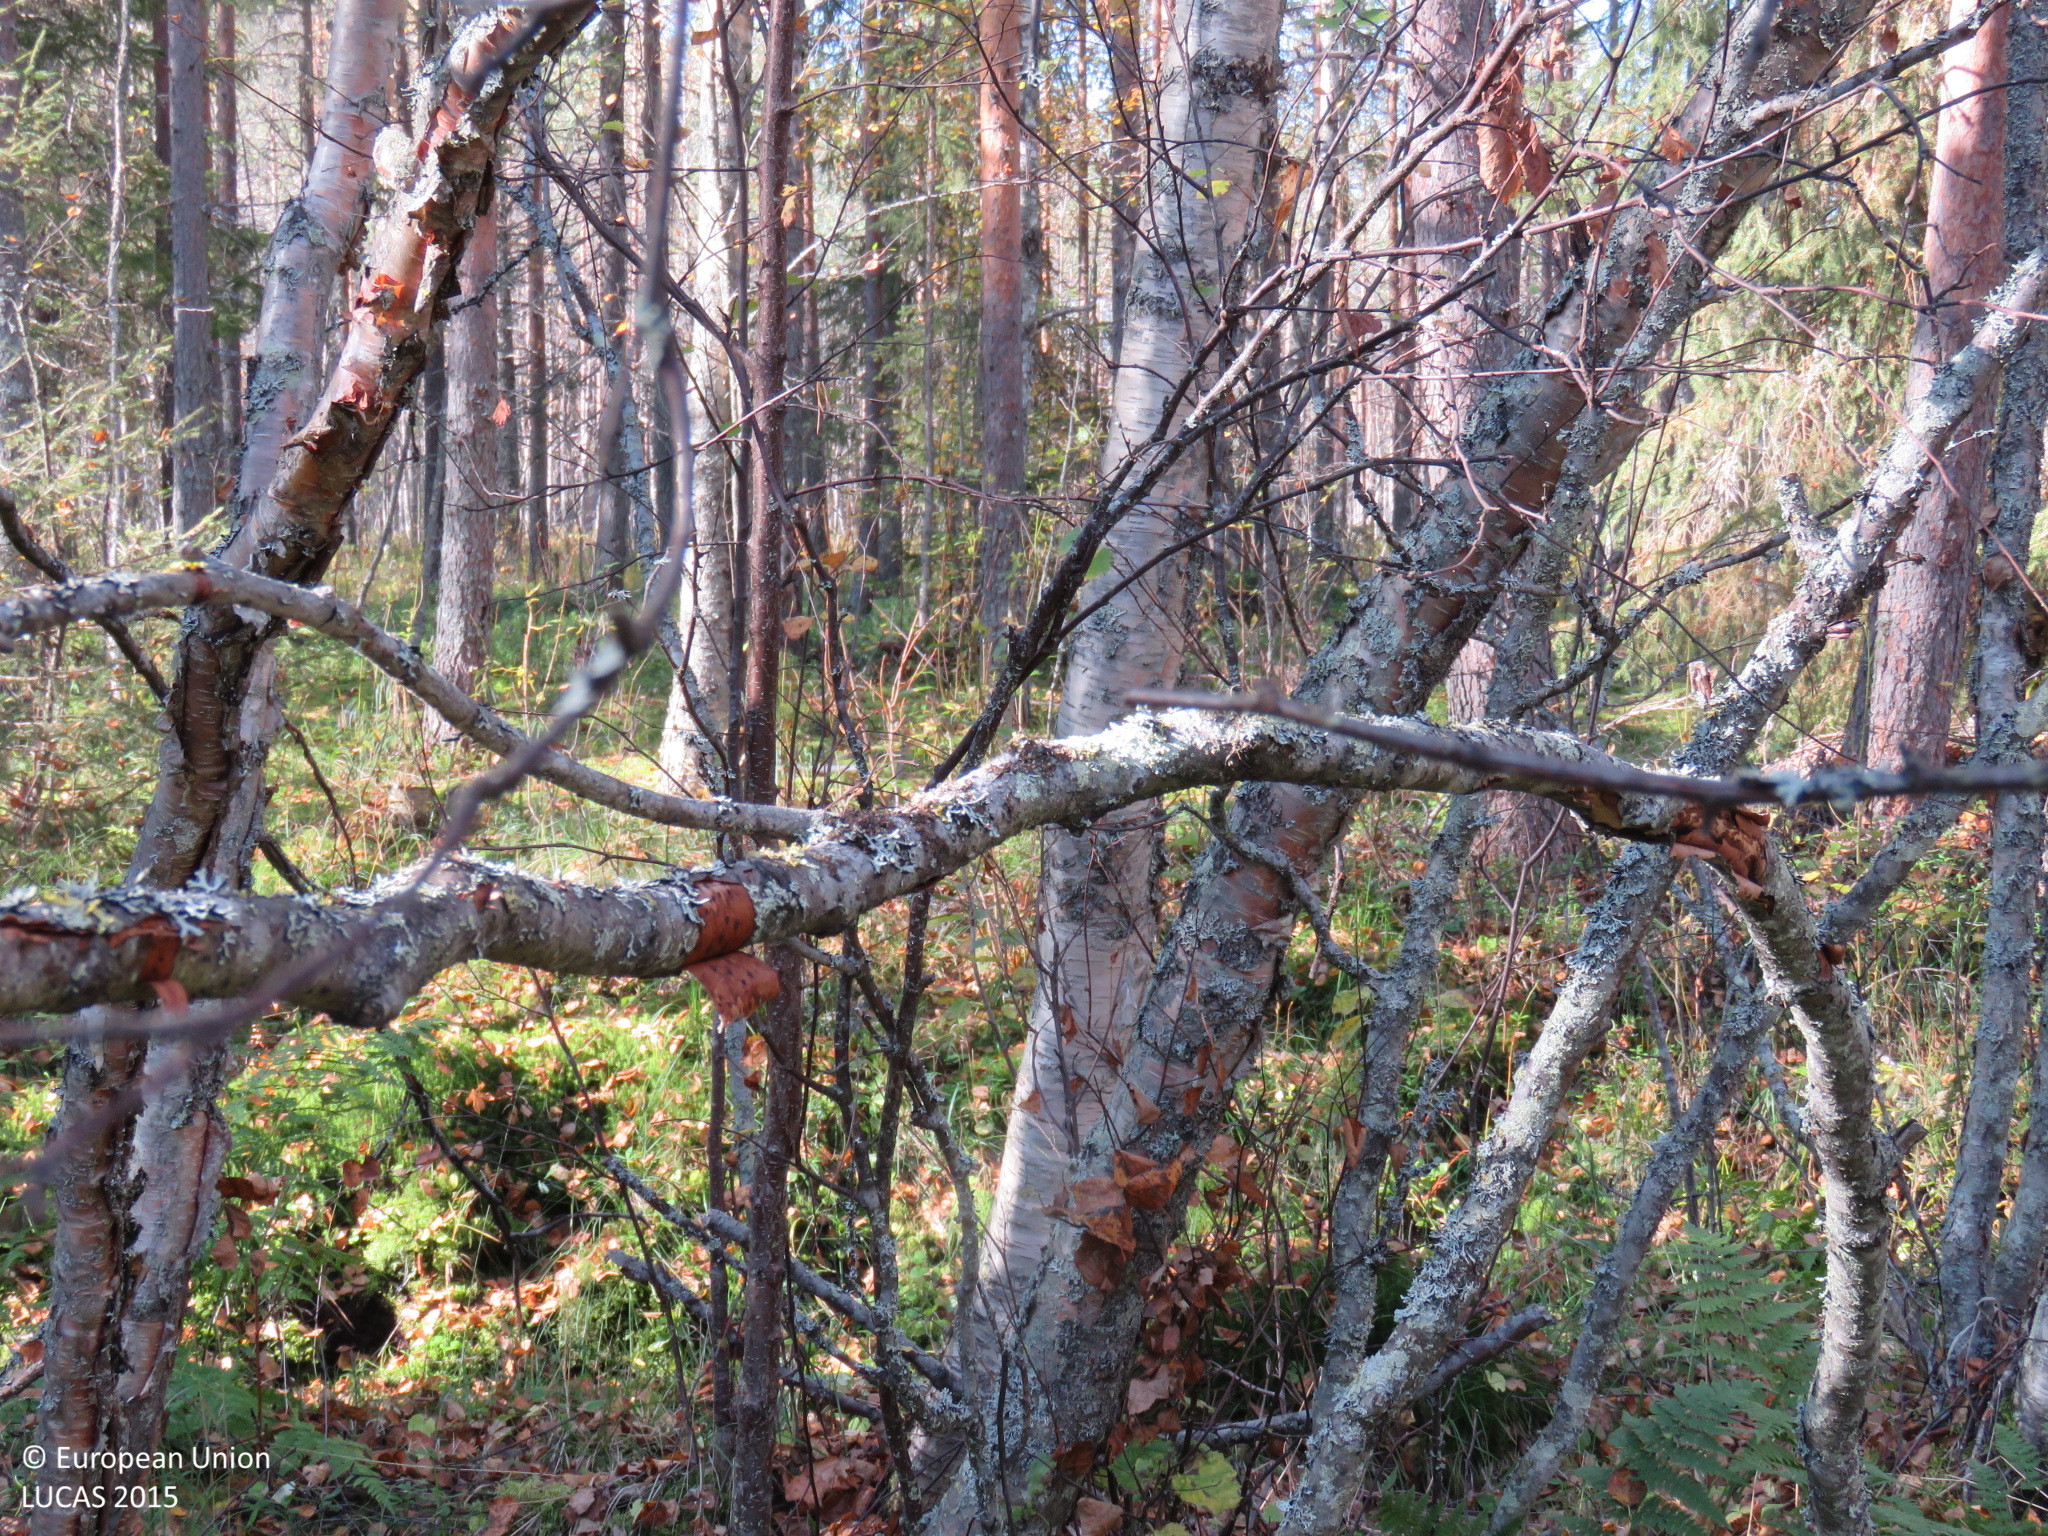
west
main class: Woodland
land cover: Broadleaved woodland
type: mire and swamp forests
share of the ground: > 75 %
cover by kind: broadleaved forest trees 75 %, coniferous forest trees 10 %, herbaceous plants 10 %, lichens and mosses 5 %
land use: Forestry
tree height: > 5 m
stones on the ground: < 10 %
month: September
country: FI
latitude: 64.9441
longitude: 26.9450
